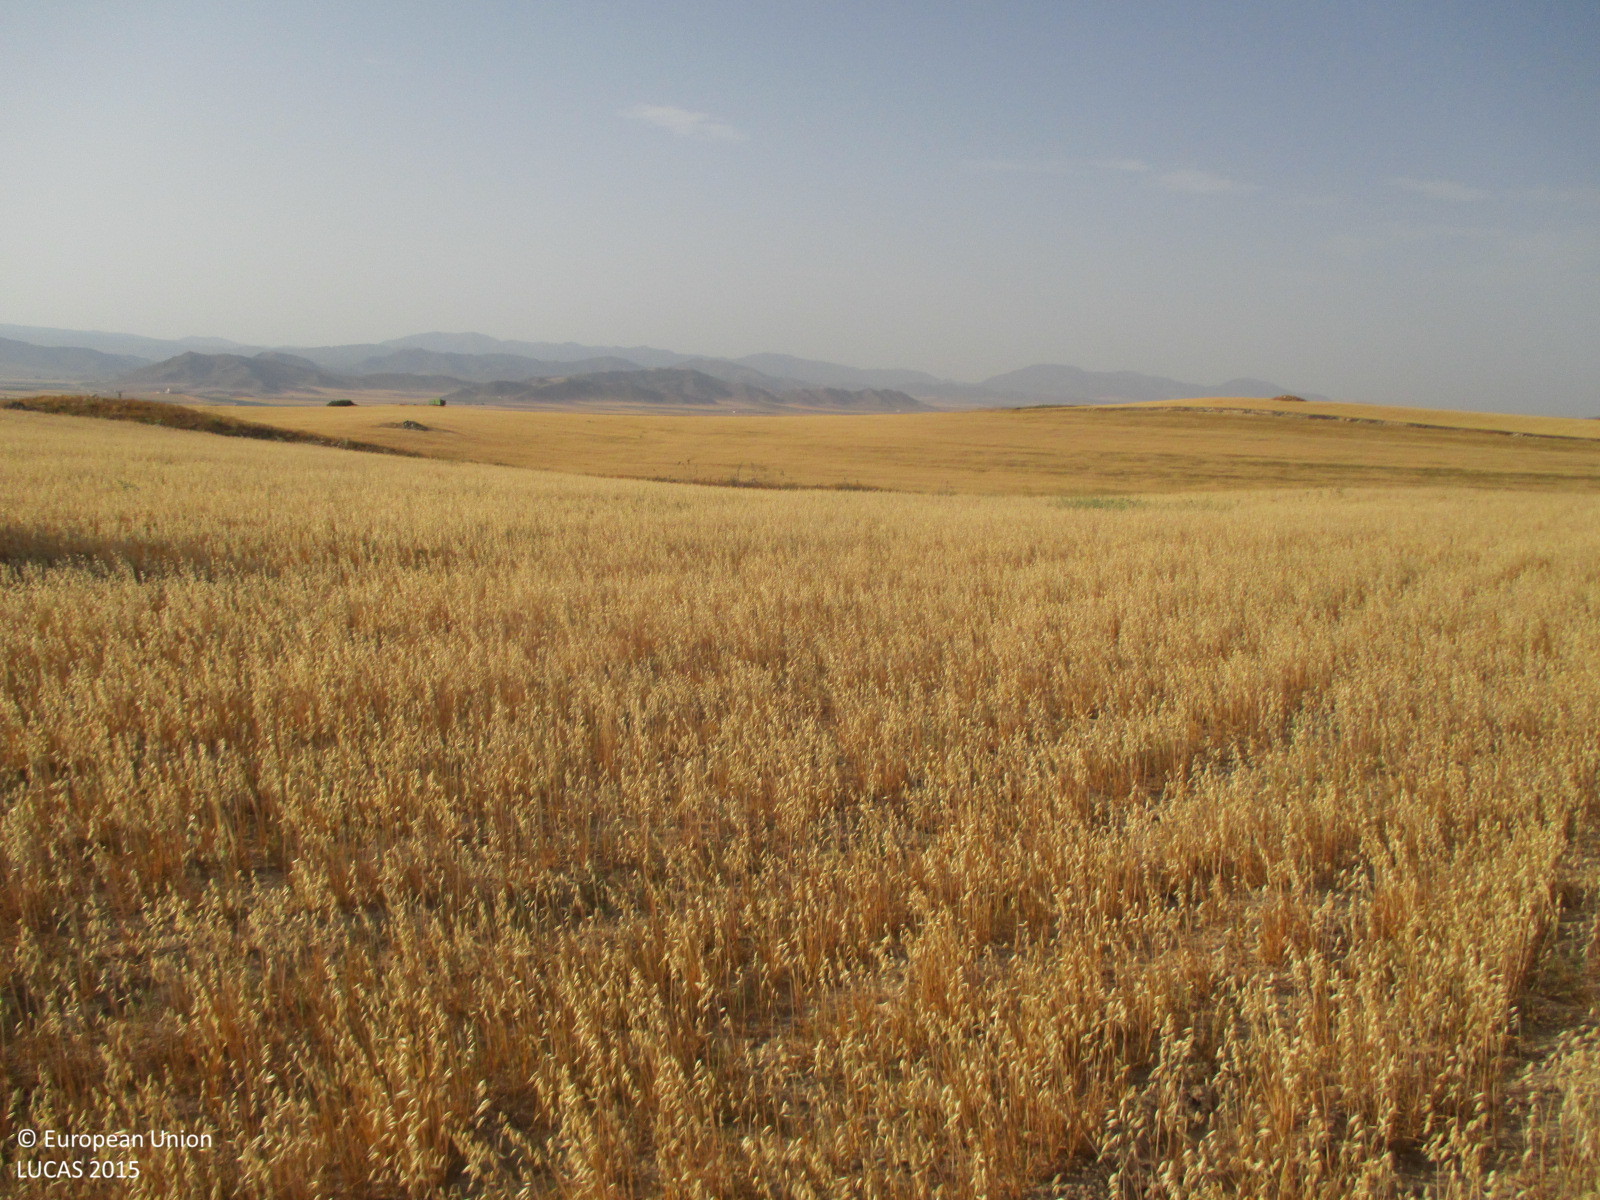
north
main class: Cropland
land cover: Oats
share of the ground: 25 - 50 %
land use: Agriculture (excluding fallow land and kitchen gardens)
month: July
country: ES
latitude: 37.8353
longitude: -2.3628
